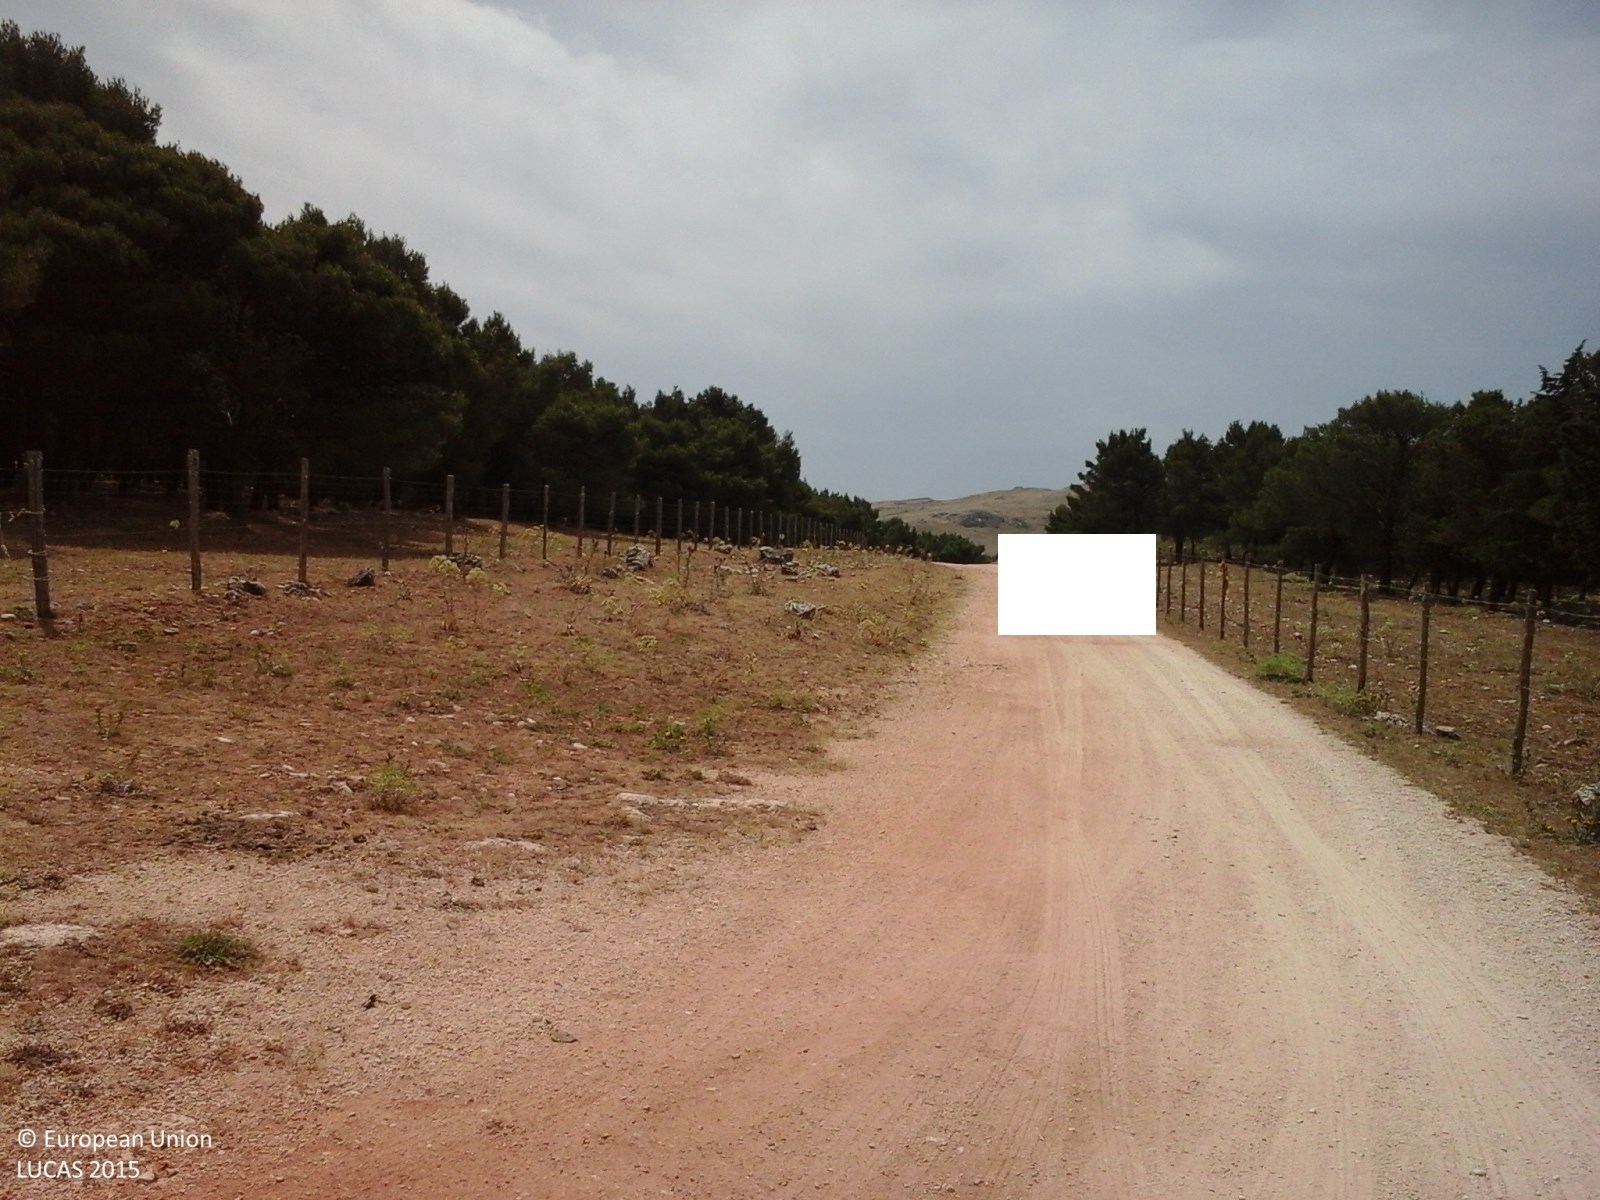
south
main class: Woodland
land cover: Pine dominated coniferous woodland
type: coniferous forest of the mediterranean region
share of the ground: > 75 %
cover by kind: coniferous forest trees 100 %
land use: Forestry
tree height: > 5 m
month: June
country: IT
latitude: 37.6231
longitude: 13.1374
